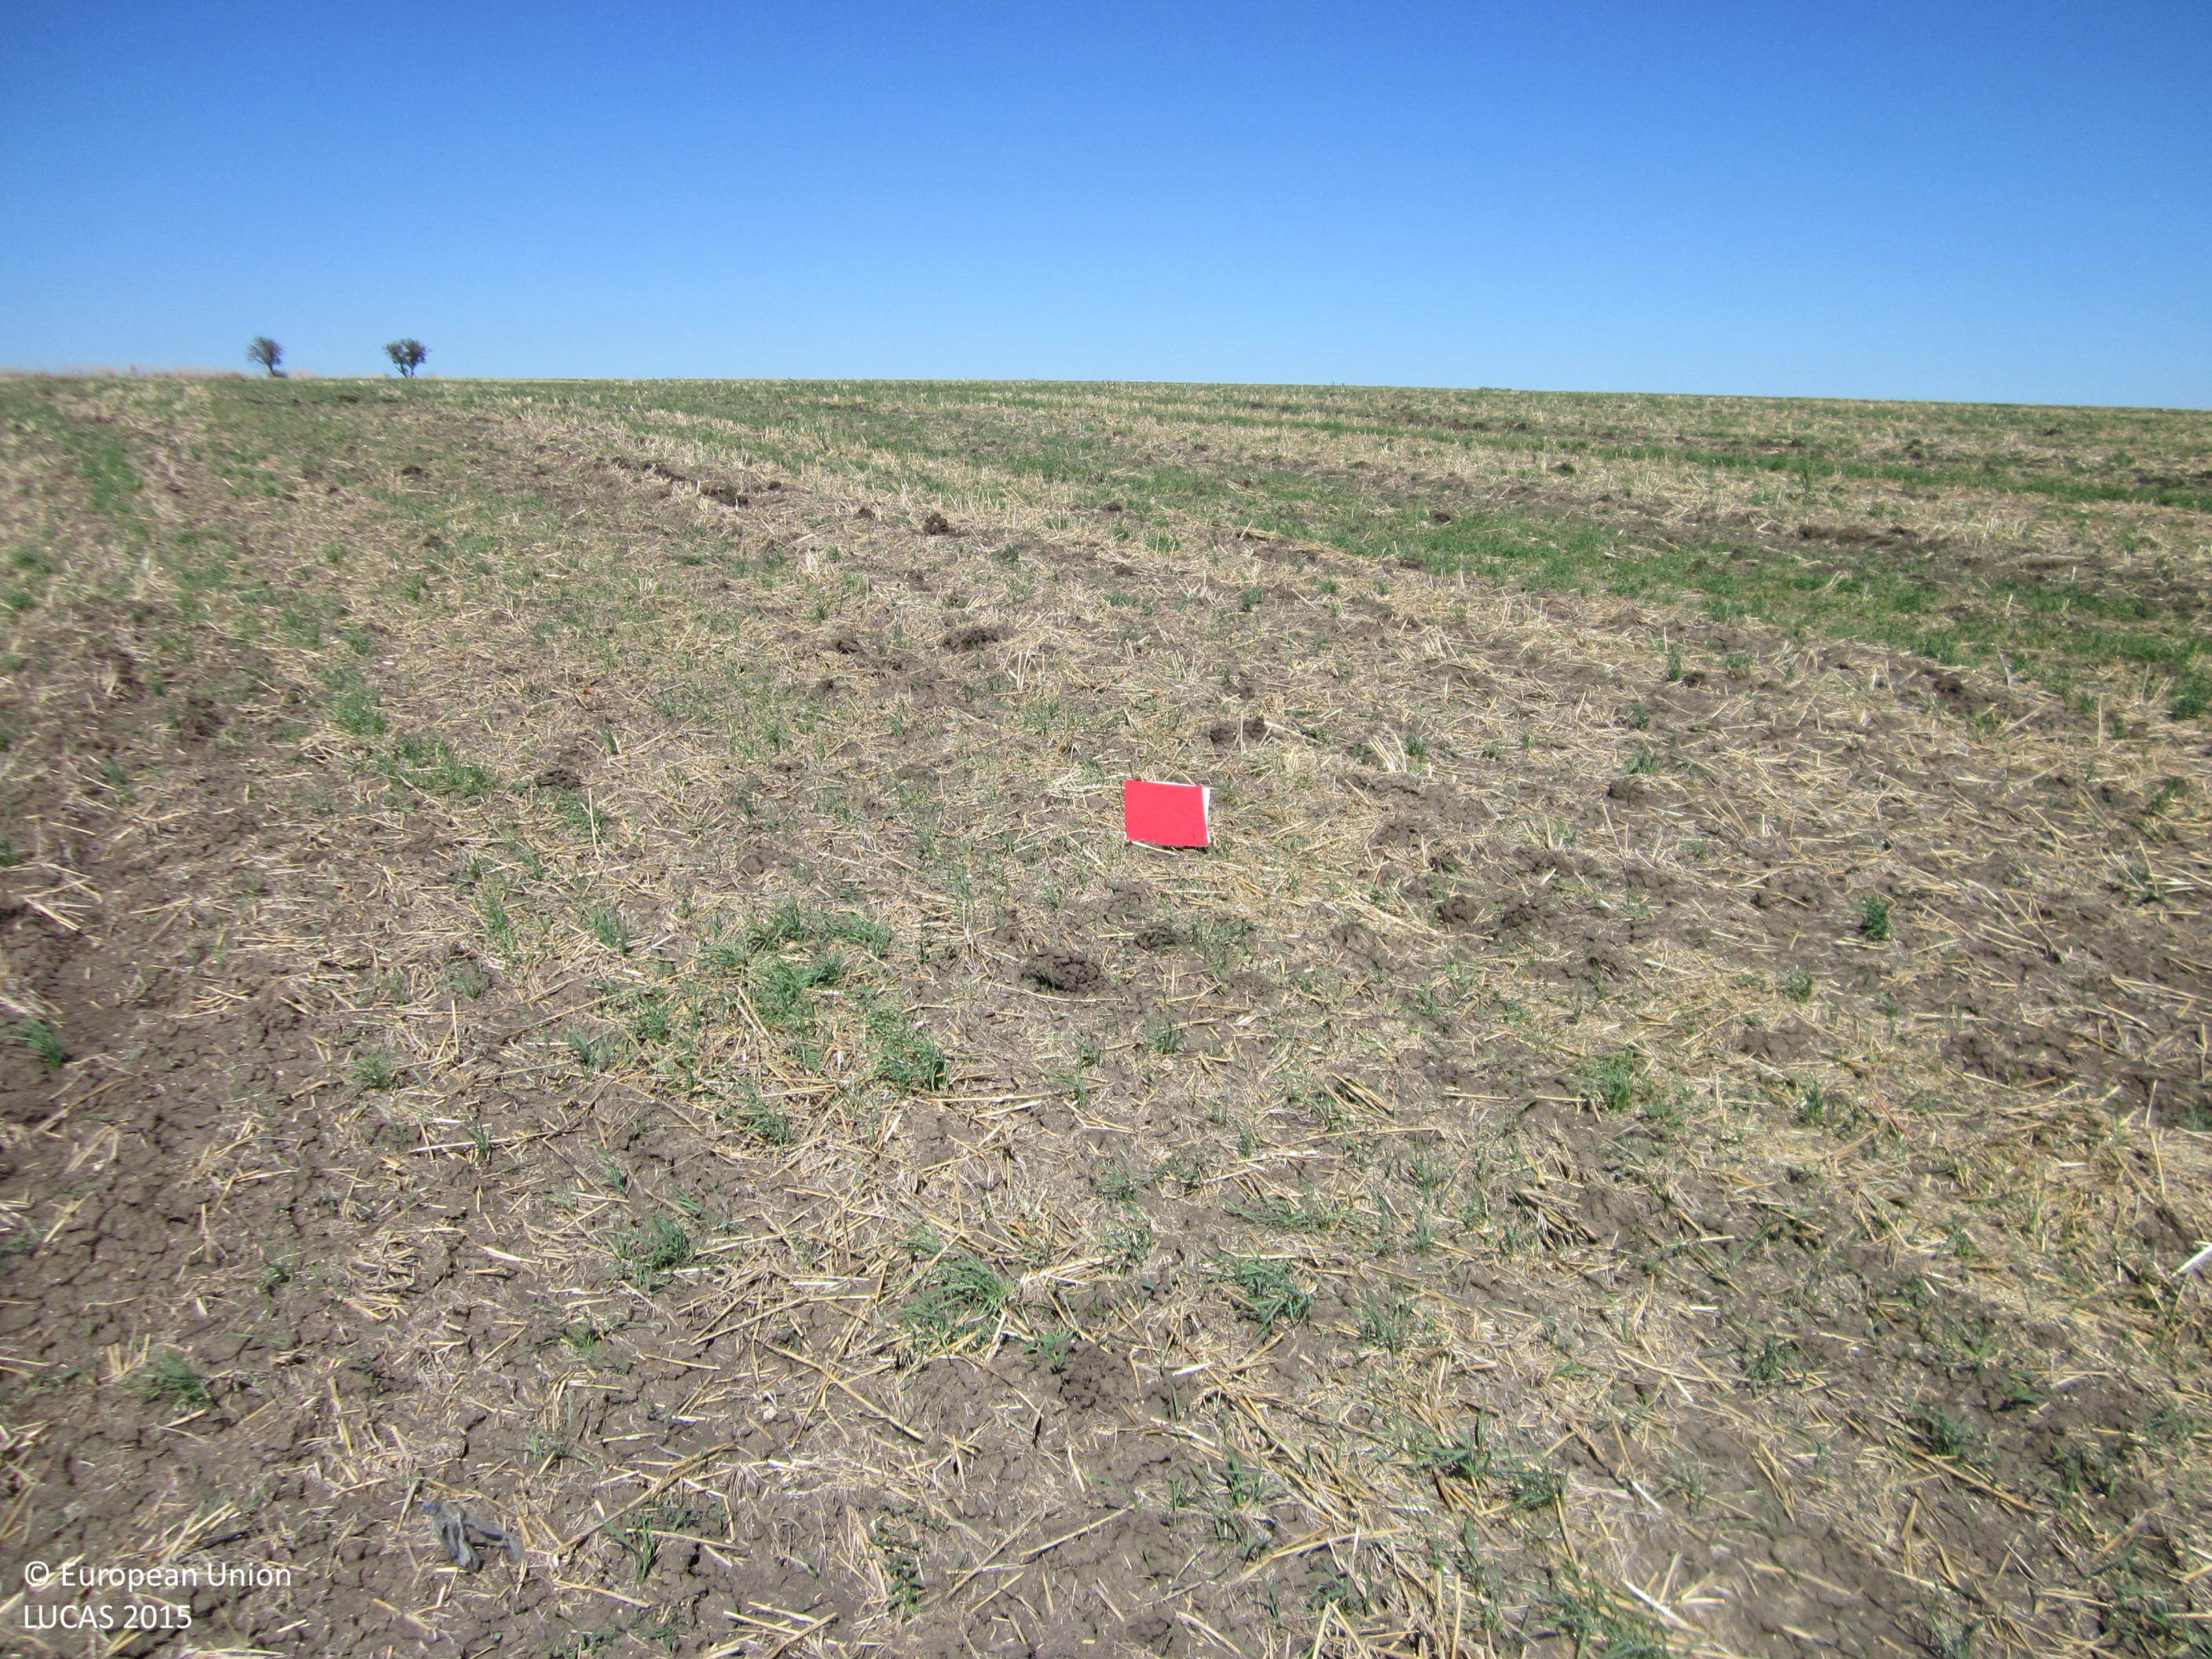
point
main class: Cropland
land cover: Common wheat
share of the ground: 25 - 50 %
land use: Agriculture (excluding fallow land and kitchen gardens)
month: September
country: BG
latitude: 42.4886
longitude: 27.0285
